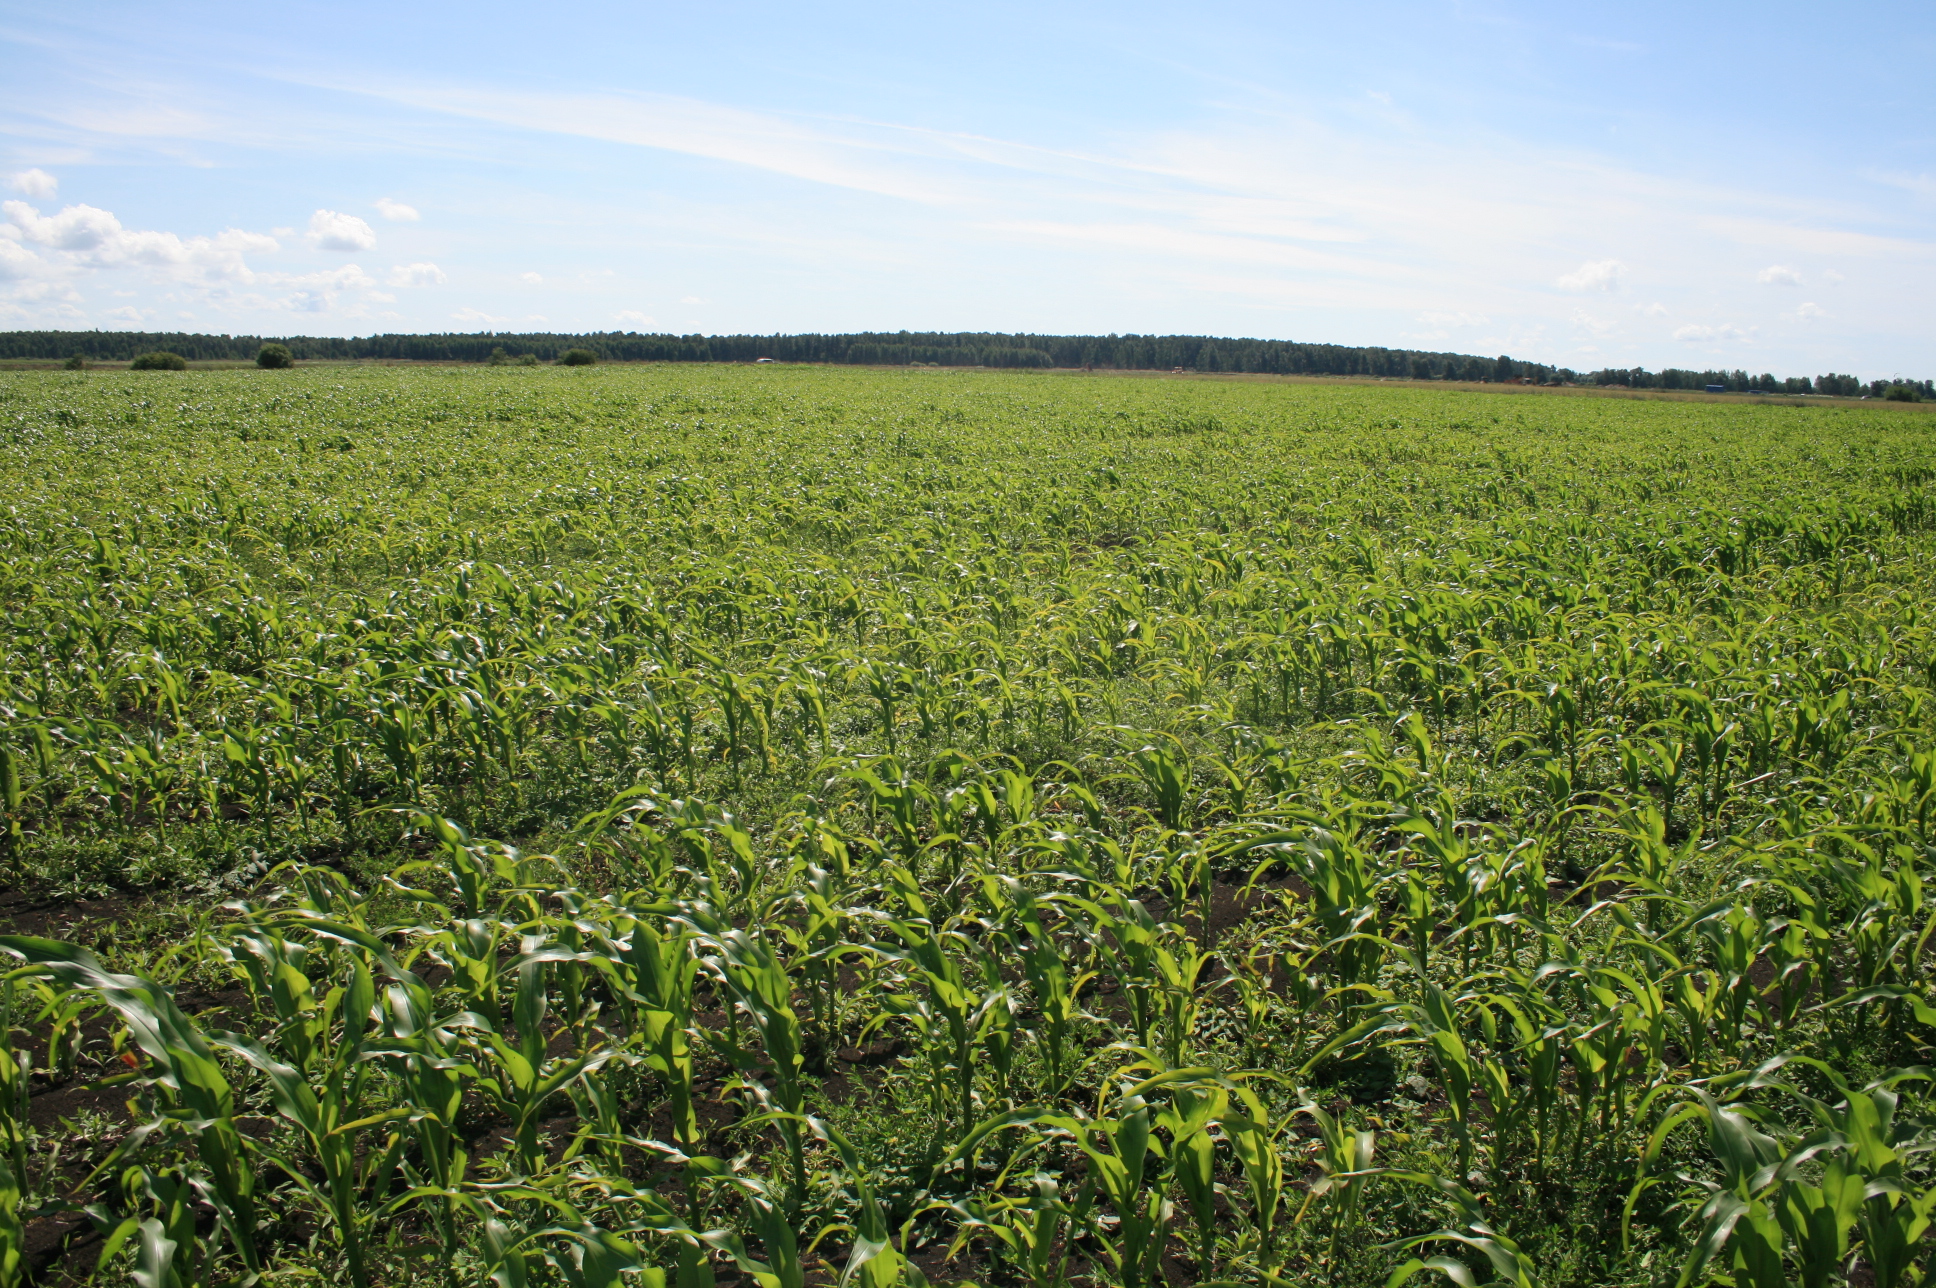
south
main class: Cropland
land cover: Maize
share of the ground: > 75 %
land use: Agriculture (excluding fallow land and kitchen gardens)
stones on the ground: < 10 %
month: July
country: LT
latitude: 55.5079
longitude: 21.2689
